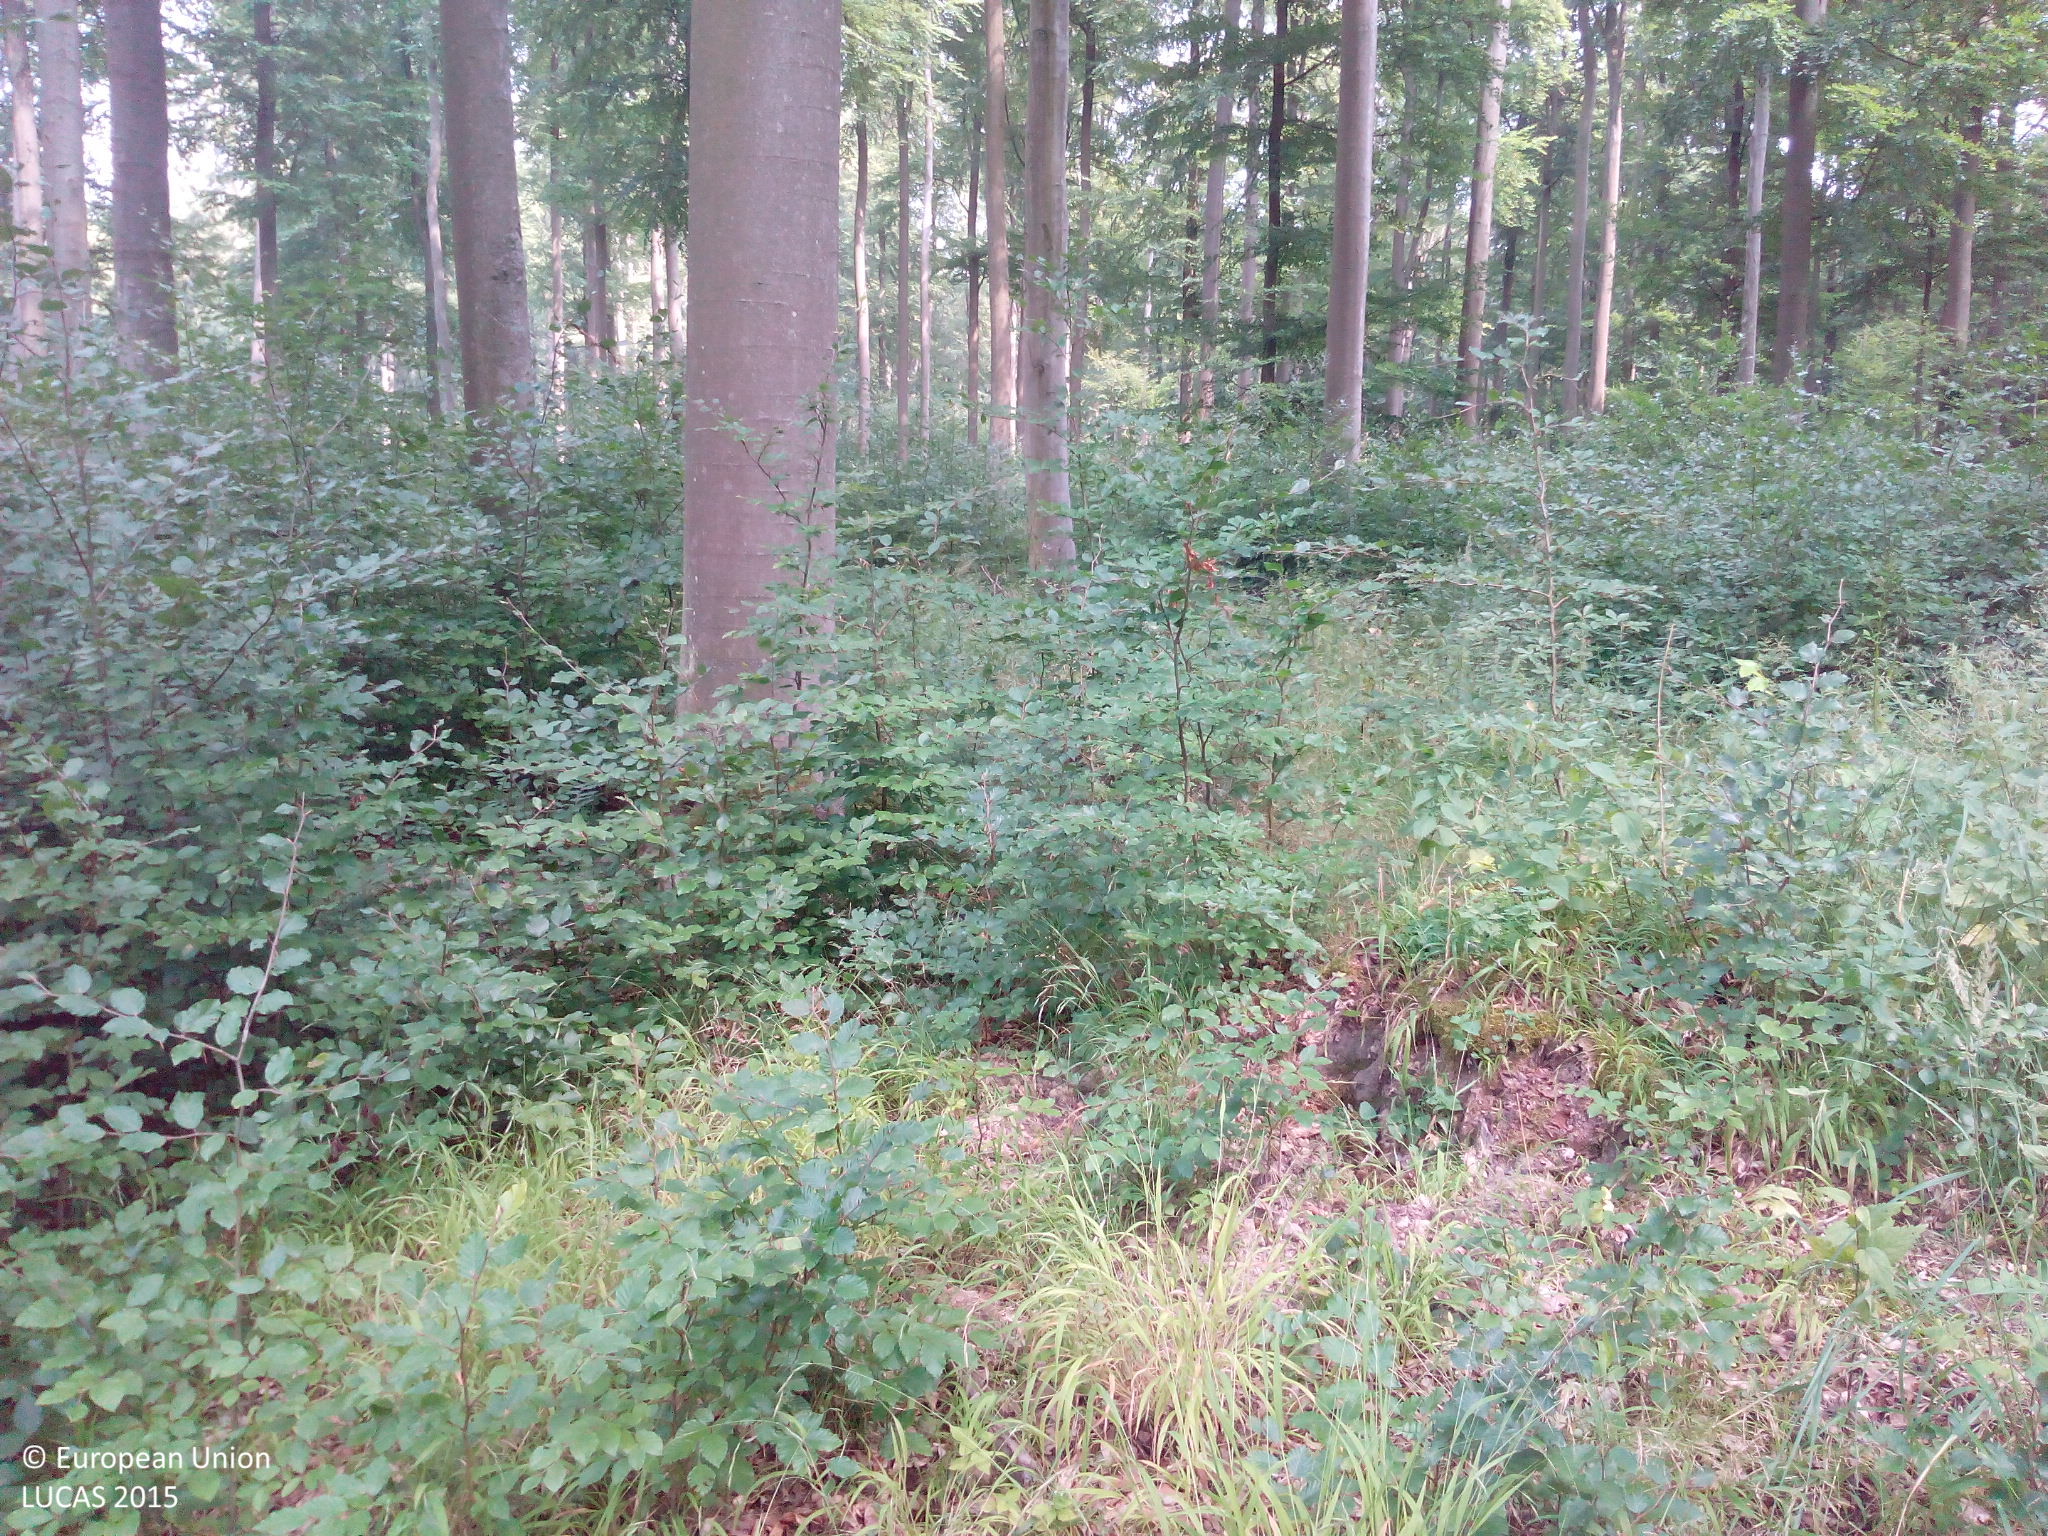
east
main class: Woodland
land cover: Broadleaved woodland
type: beech forest
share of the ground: > 75 %
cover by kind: broadleaved forest trees 70 %, coniferous forest trees 10 %, shrubs 10 %, herbaceous plants 10 %
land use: Forestry
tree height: > 5 m
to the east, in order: Broadleaved woodland; Tracks; Broadleaved woodland
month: August
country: DE
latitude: 50.2764
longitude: 8.1061
